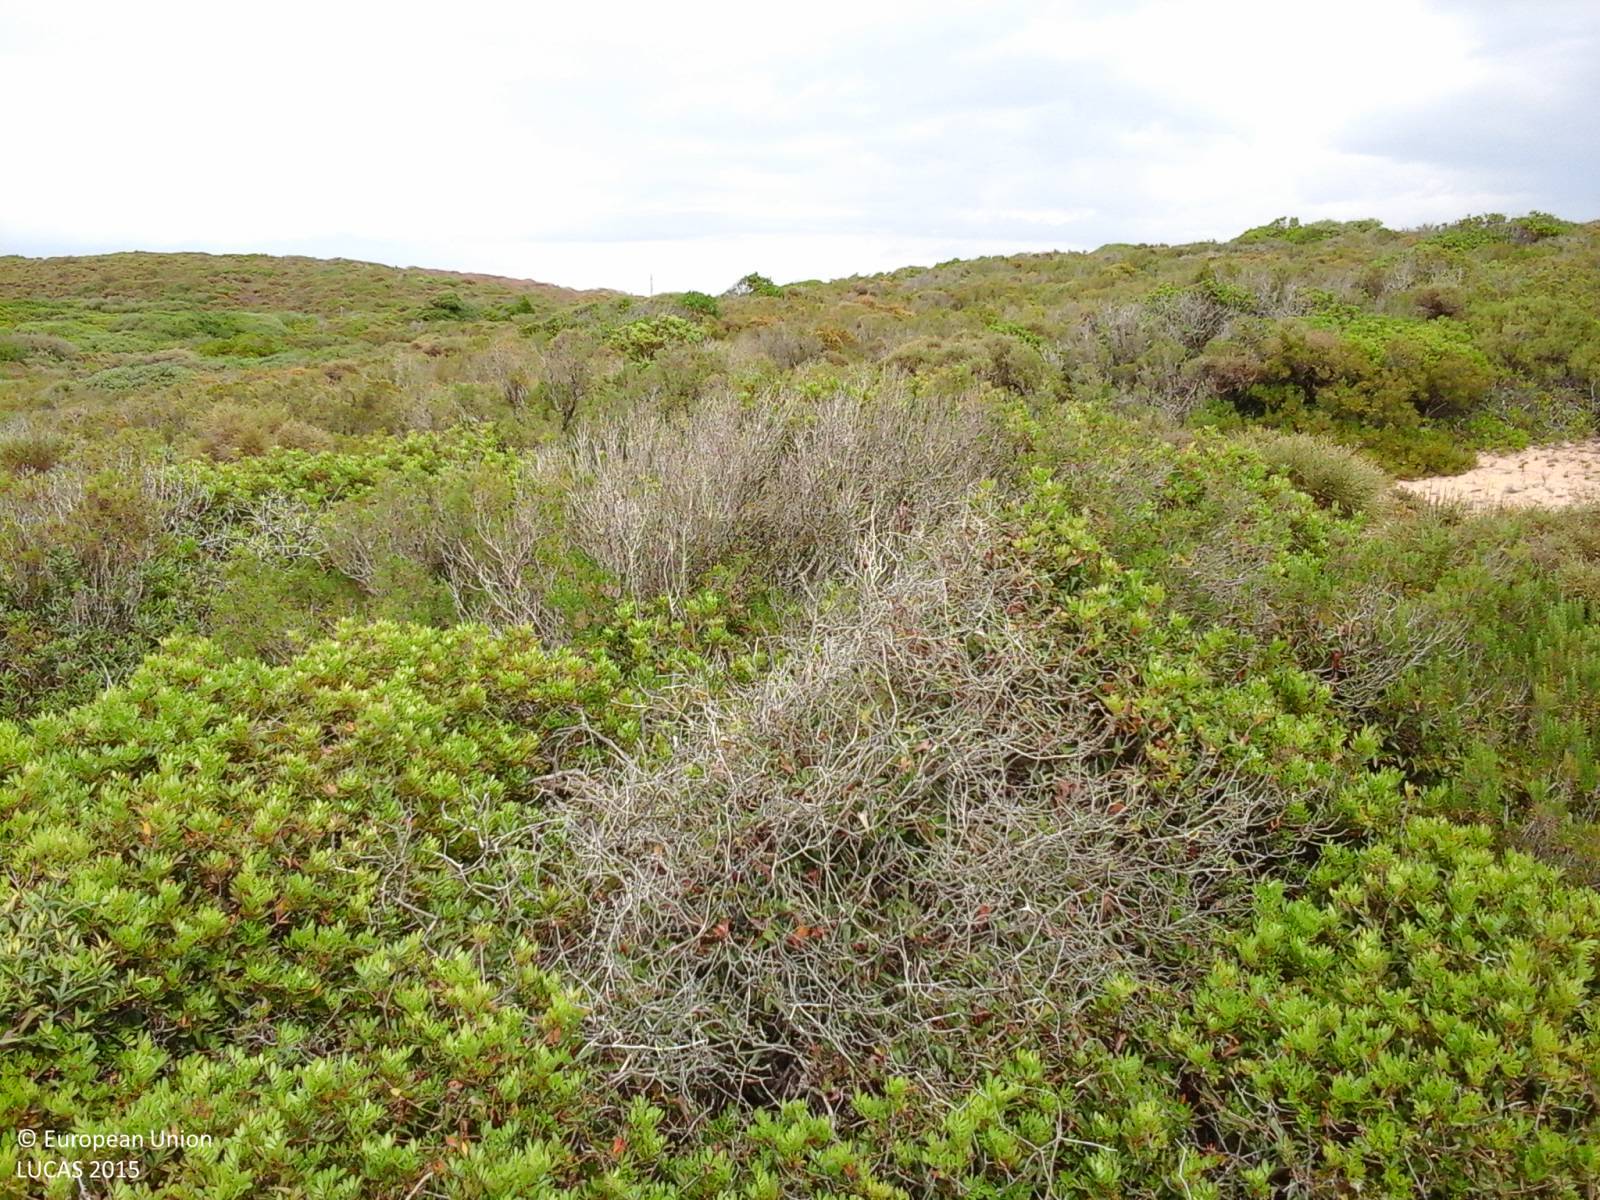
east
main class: Shrubland
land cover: Shrubland without tree cover
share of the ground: > 75 %
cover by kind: shrubs 70 %, herbaceous plants 30 %
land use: Semi-natural and natural areas not in use
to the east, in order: Shrubland without tree cover; Tracks; Sand; Shrubland without tree cover
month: June
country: IT
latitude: 39.6938
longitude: 8.4579
